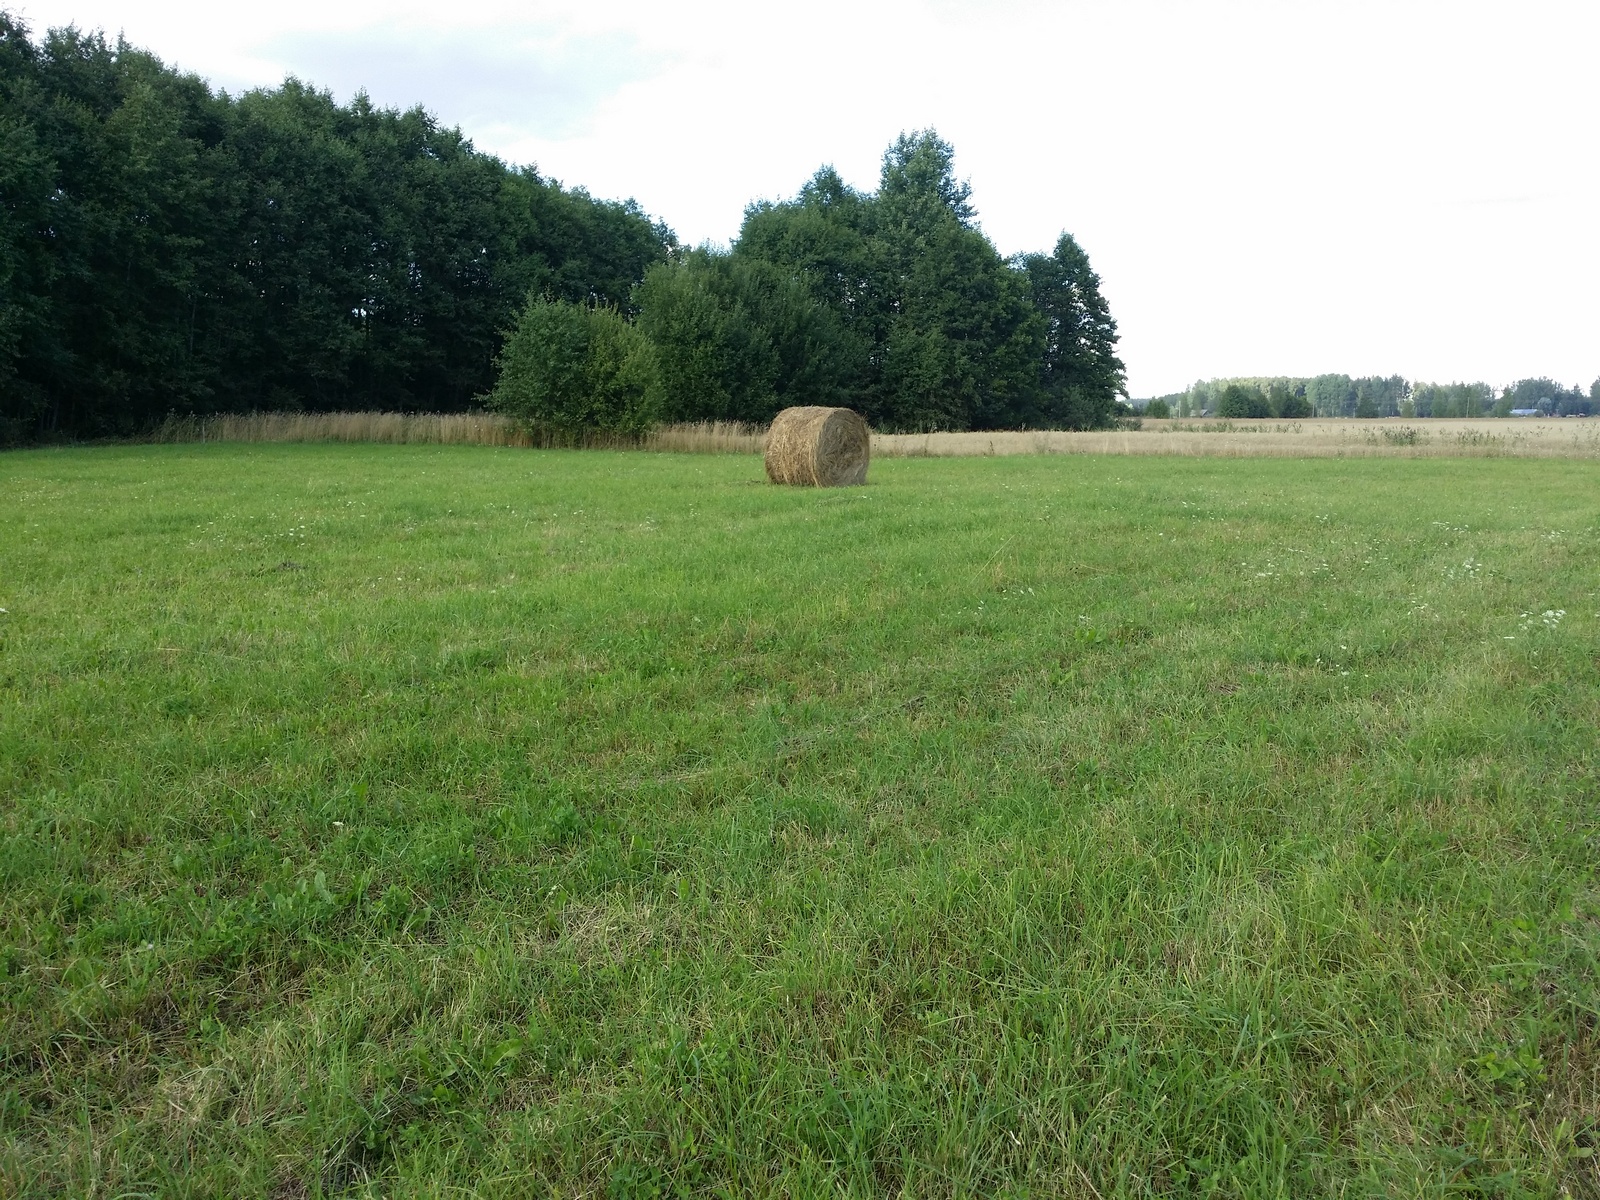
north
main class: Grassland
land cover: Grassland without tree/shrub cover
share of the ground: > 75 %
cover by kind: herbaceous plants 85 %, unconsolidated bare surface 15 %
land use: Agriculture (excluding fallow land and kitchen gardens)
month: August
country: LV
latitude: 56.9562
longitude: 27.5596
